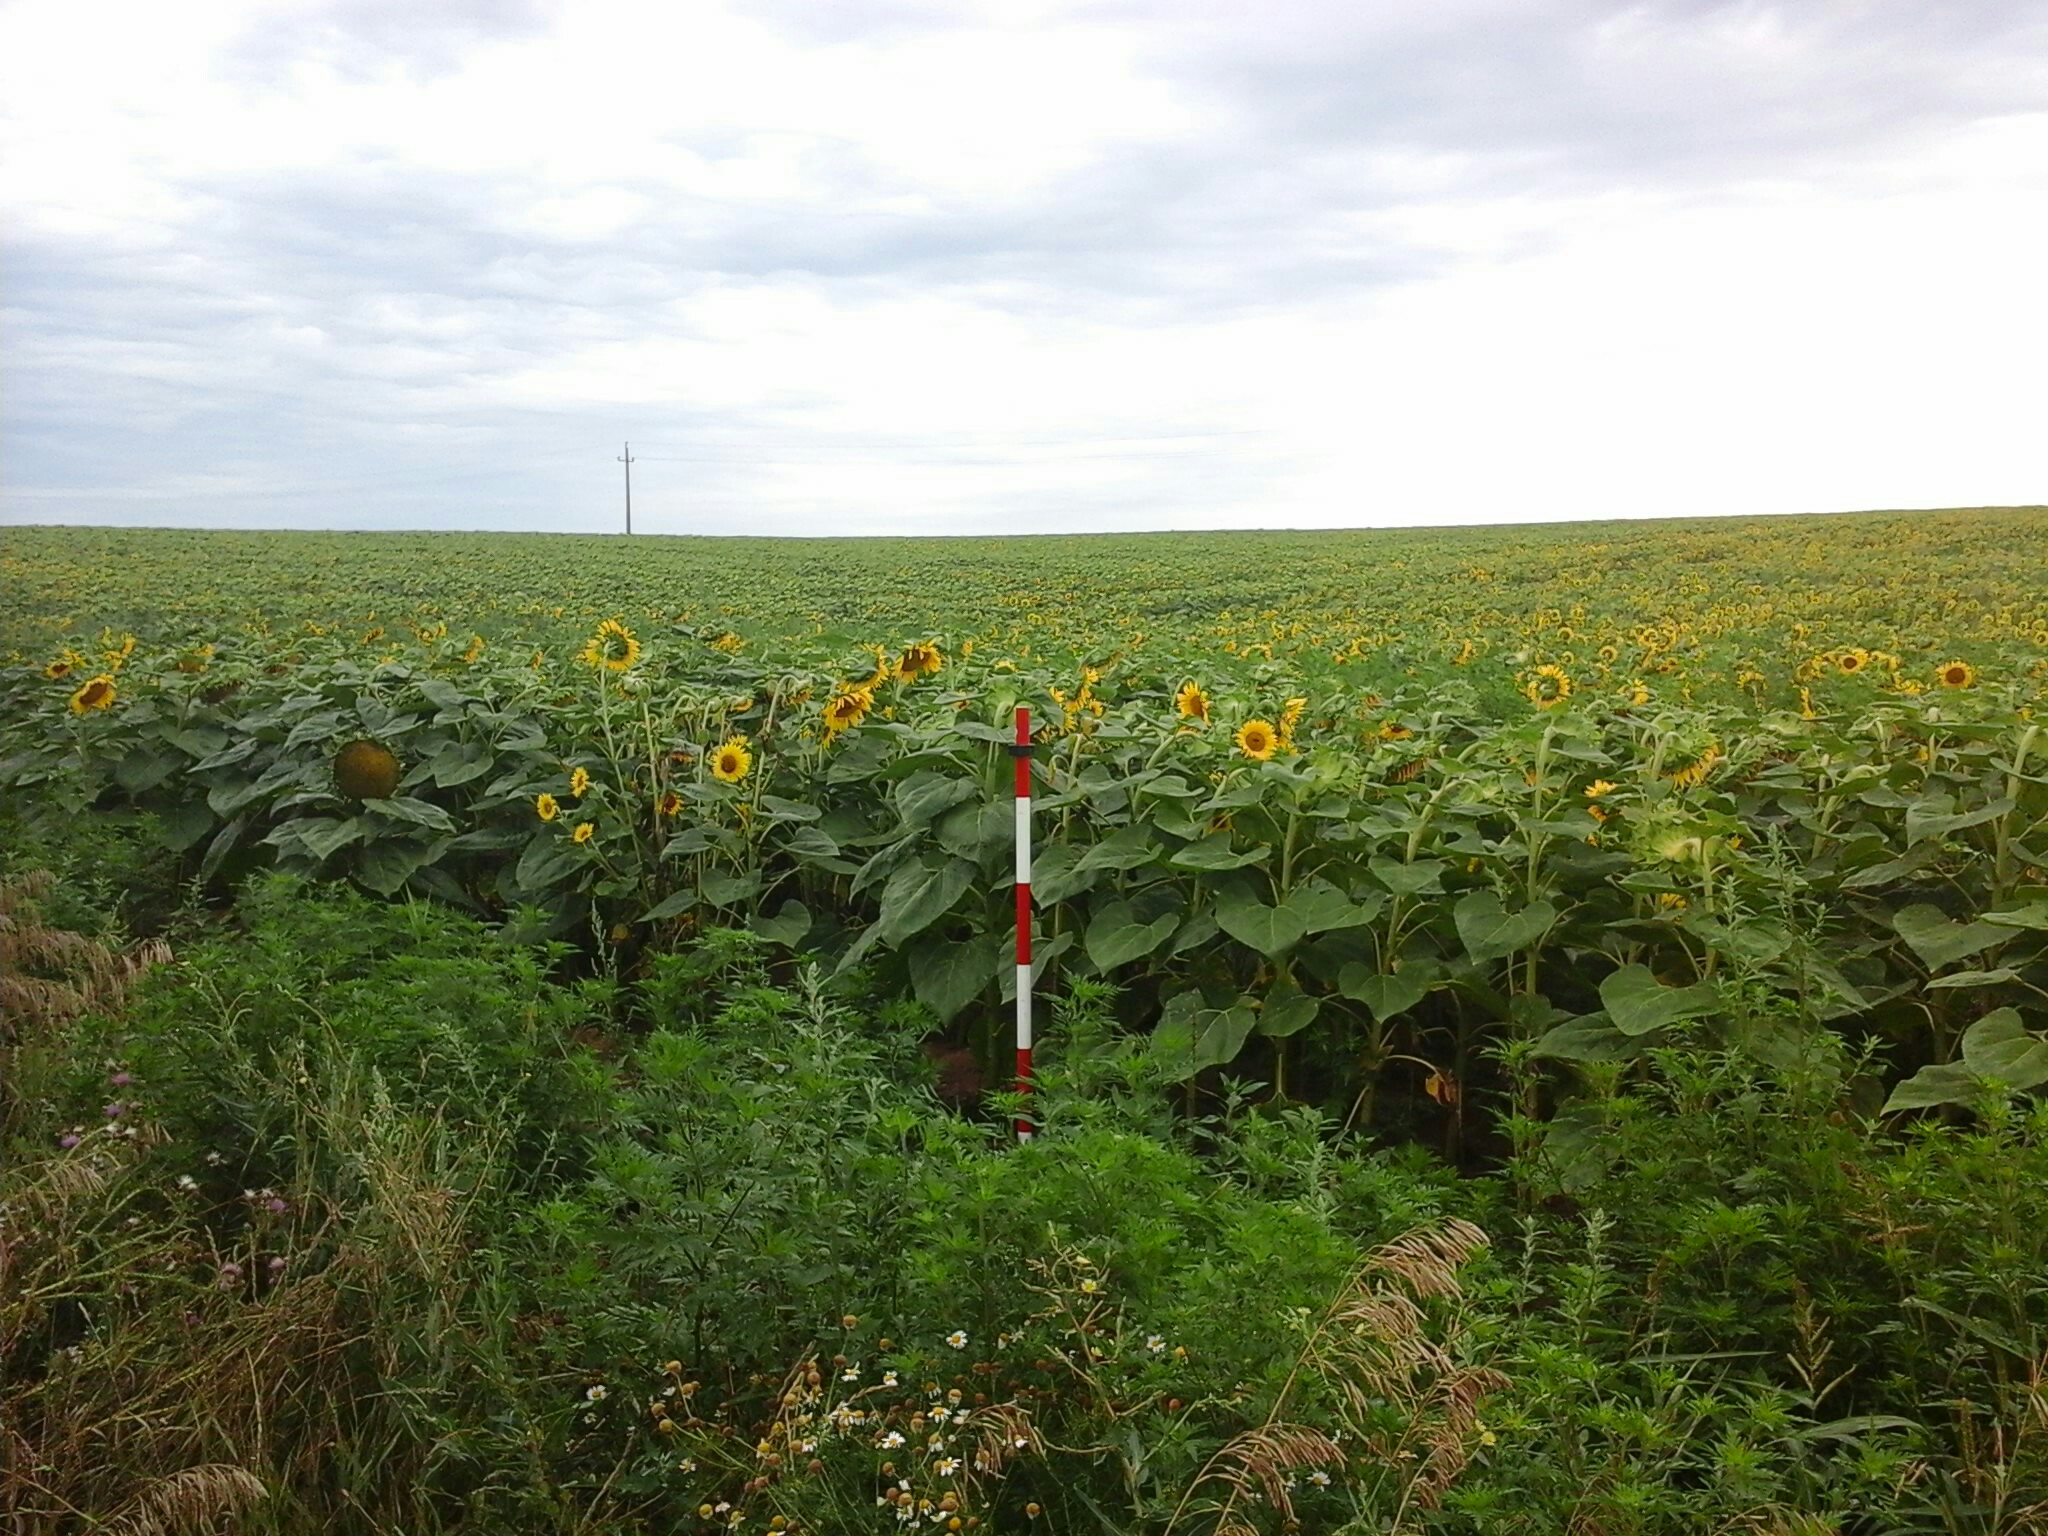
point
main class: Cropland
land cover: Sunflower
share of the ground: > 75 %
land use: Agriculture (excluding fallow land and kitchen gardens)
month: July
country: HU
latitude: 48.4530
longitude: 21.1706
